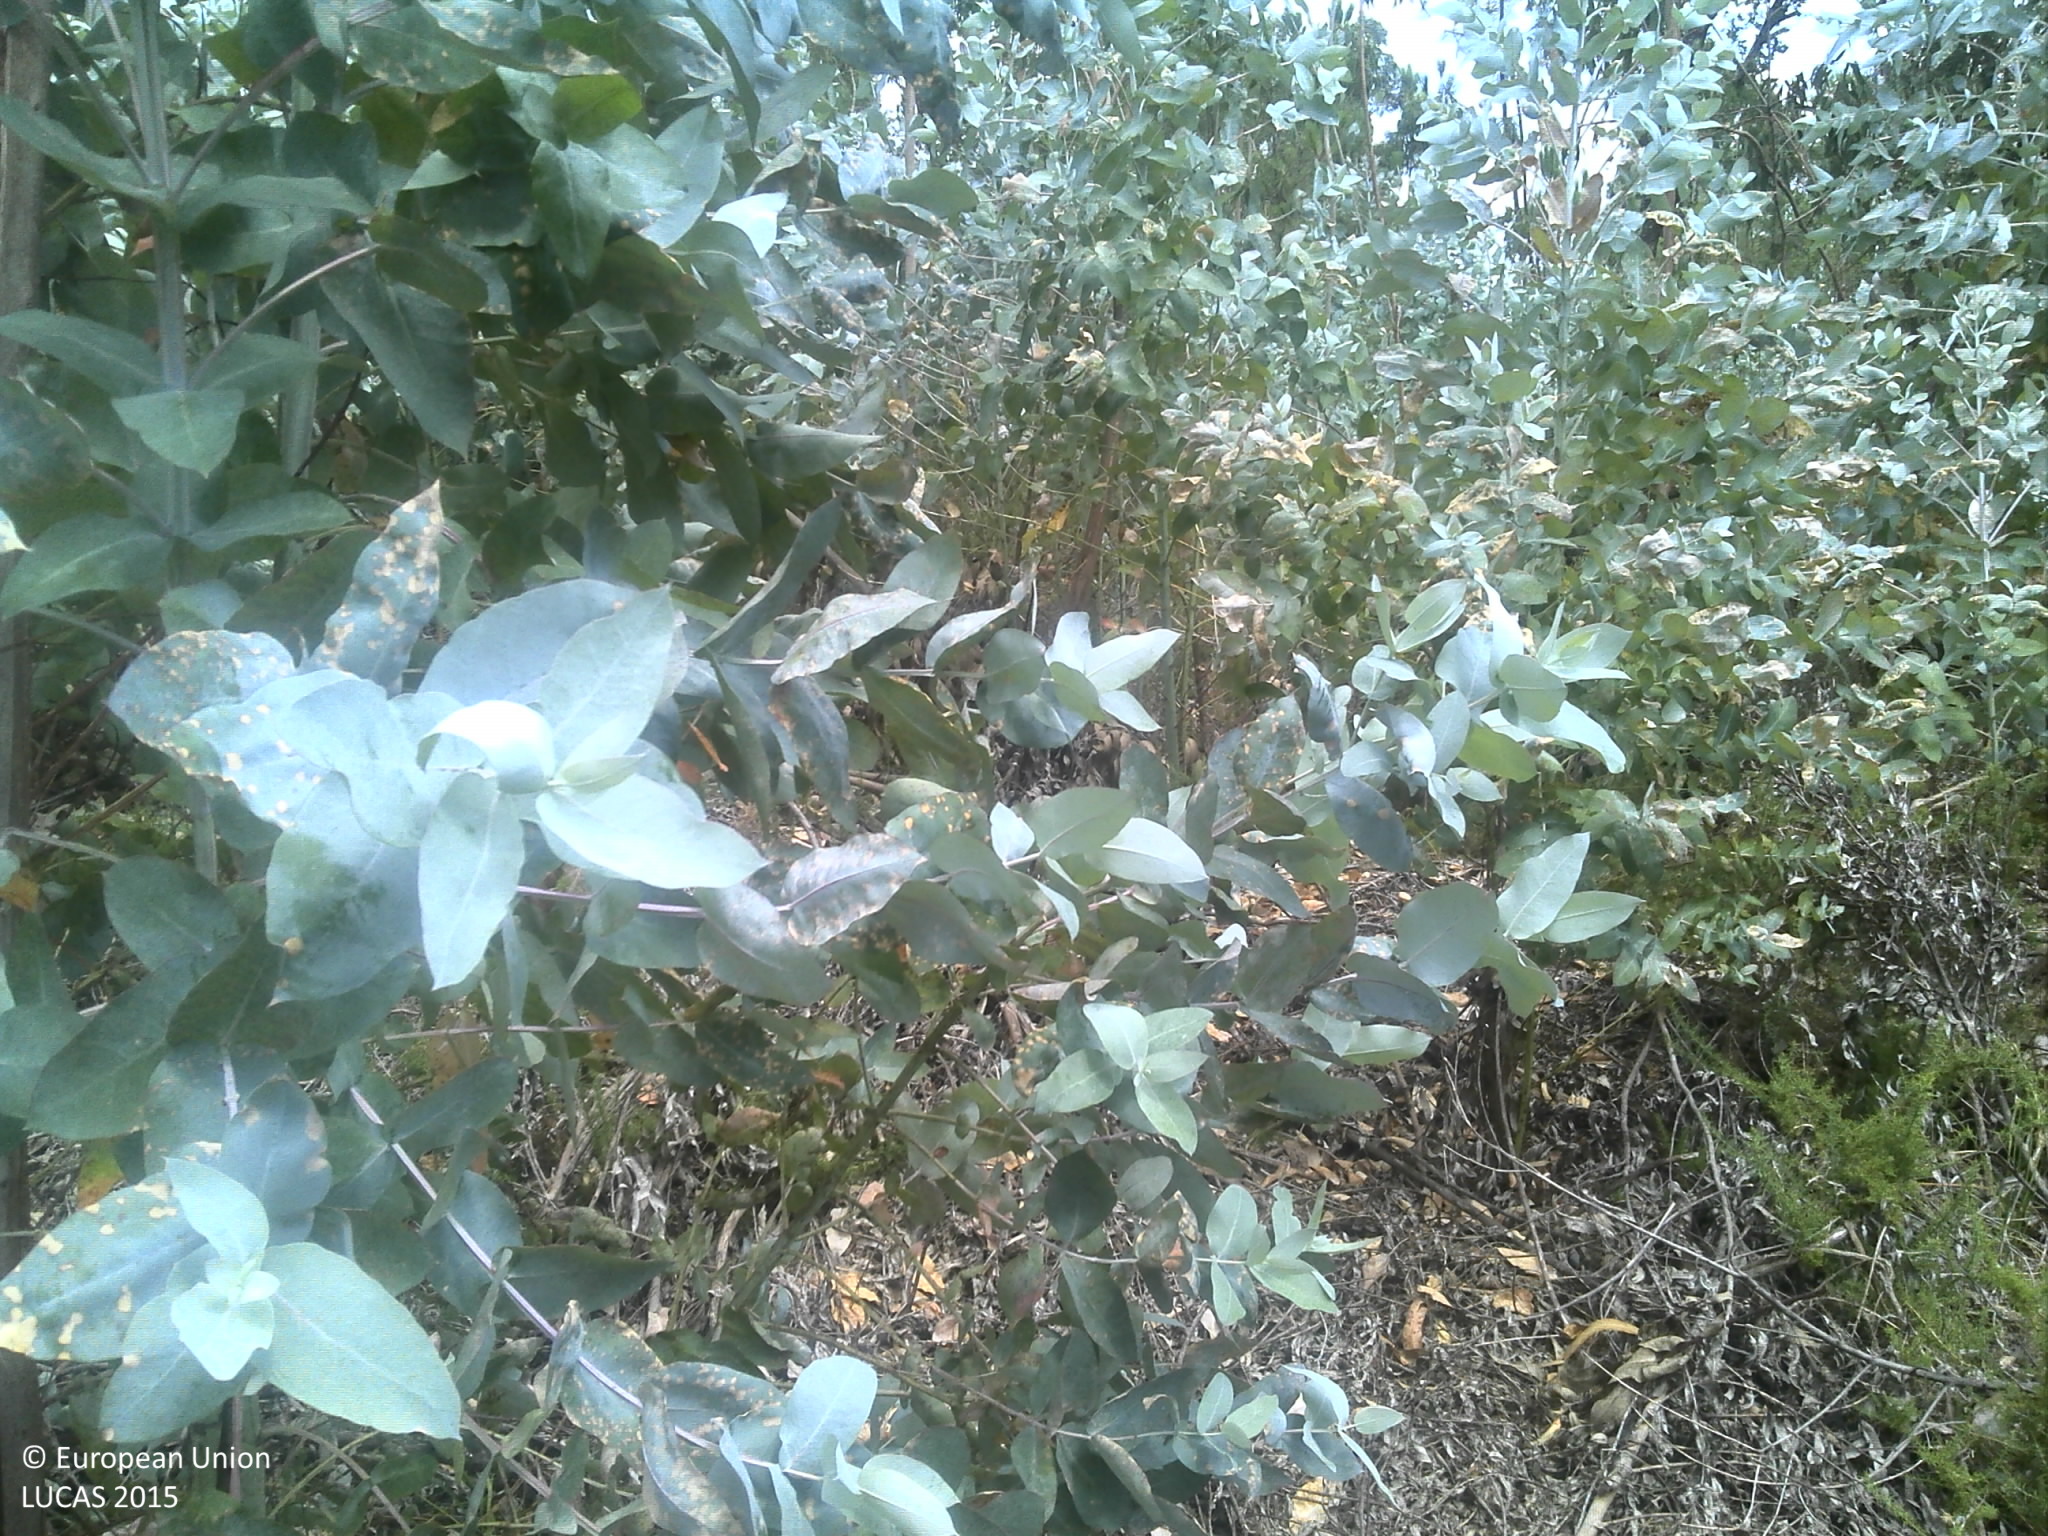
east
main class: Woodland
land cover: Broadleaved woodland
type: exotic forest
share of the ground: 25 - 50 %
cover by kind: broadleaved forest trees 50 %, unconsolidated bare surface 40 %, shrubs 10 %
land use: Forestry
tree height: < 5 m
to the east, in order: Broadleaved woodland; Tracks; Broadleaved woodland; Tracks; Shrubland without tree cover; Rock outcrops; Shrubland without tree cover; Rock outcrops; Shrubland without tree cover; Rock outcrops; Shrubland without tree cover; Rock outcrops; Shrubland without tree cover
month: June
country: PT
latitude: 41.5666
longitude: -8.5657
